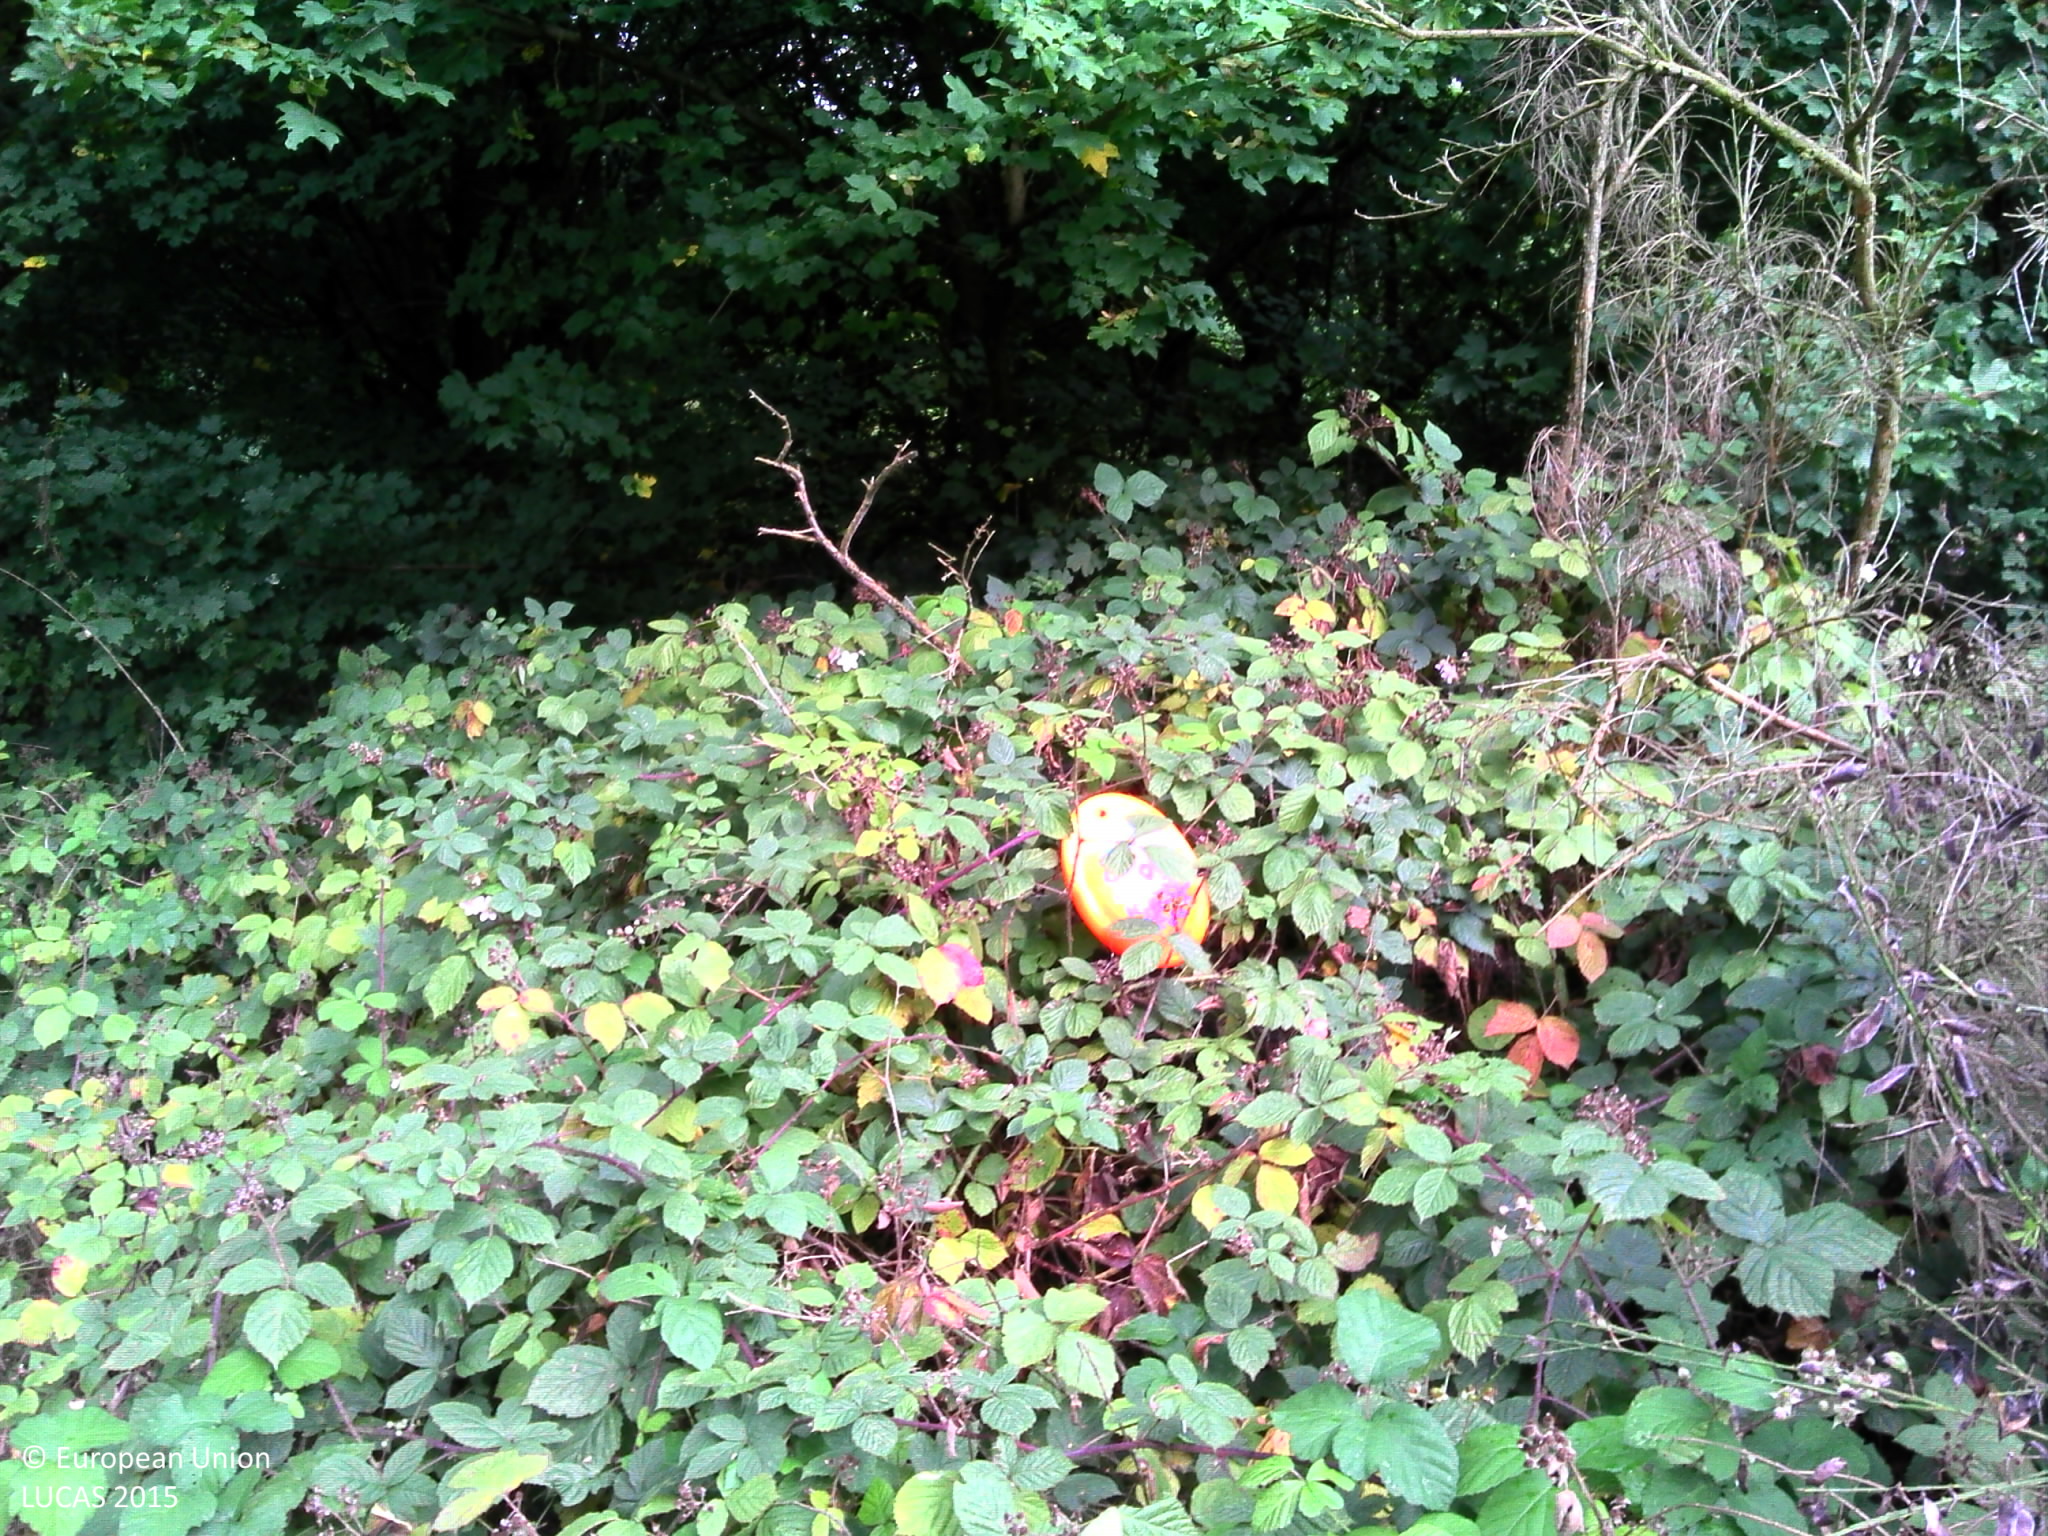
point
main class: Woodland
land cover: Broadleaved woodland
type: mesophytic deciduous forest
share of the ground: > 75 %
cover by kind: broadleaved forest trees 90 %, shrubs 5 %, herbaceous plants 5 %
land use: Amenities, museums, leisure
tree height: > 5 m
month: September
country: BE
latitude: 51.1657
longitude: 4.4325
